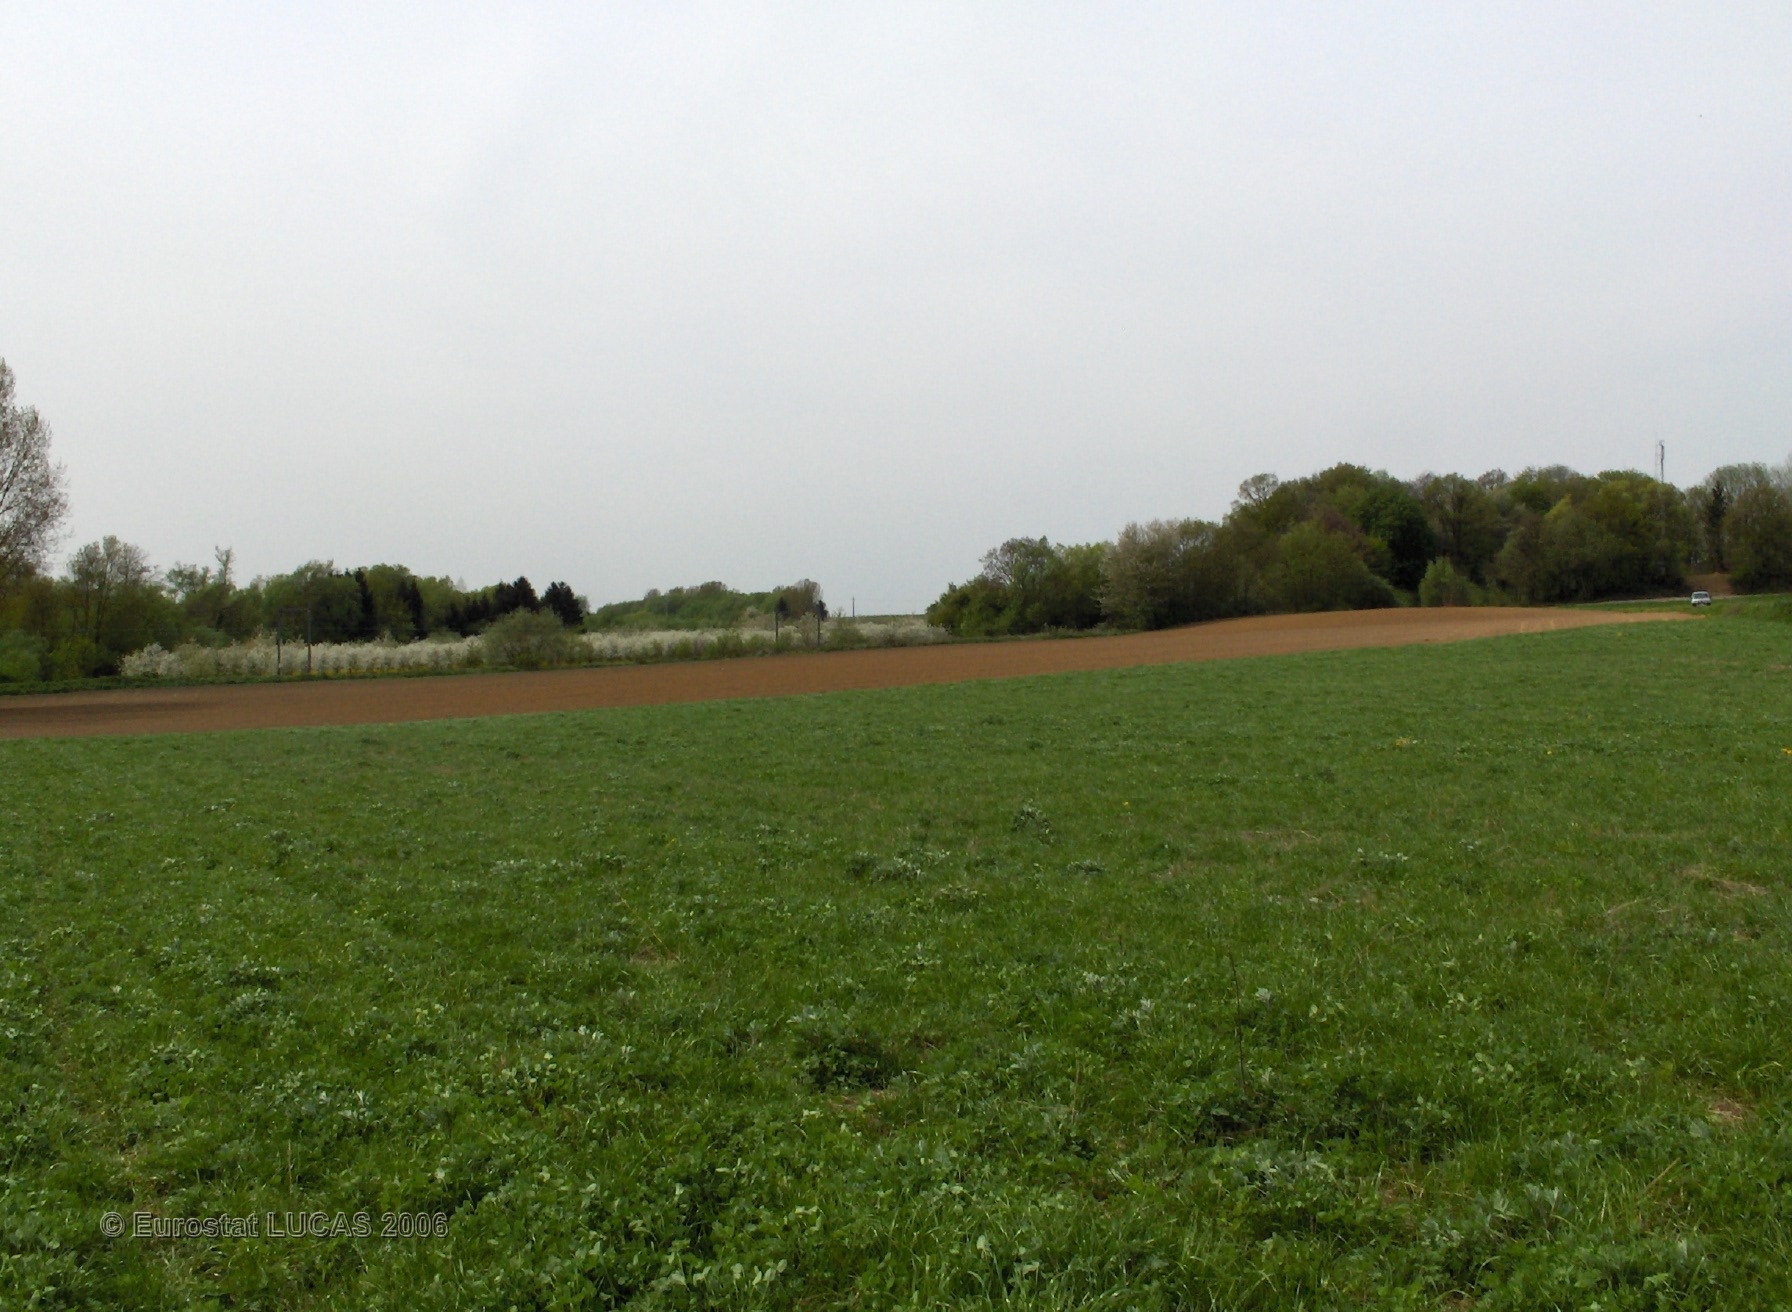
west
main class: Grassland
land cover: Grassland without tree/shrub cover
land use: Agriculture (excluding fallow land and kitchen gardens)
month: May
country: BE
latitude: 50.7135
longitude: 5.1965
